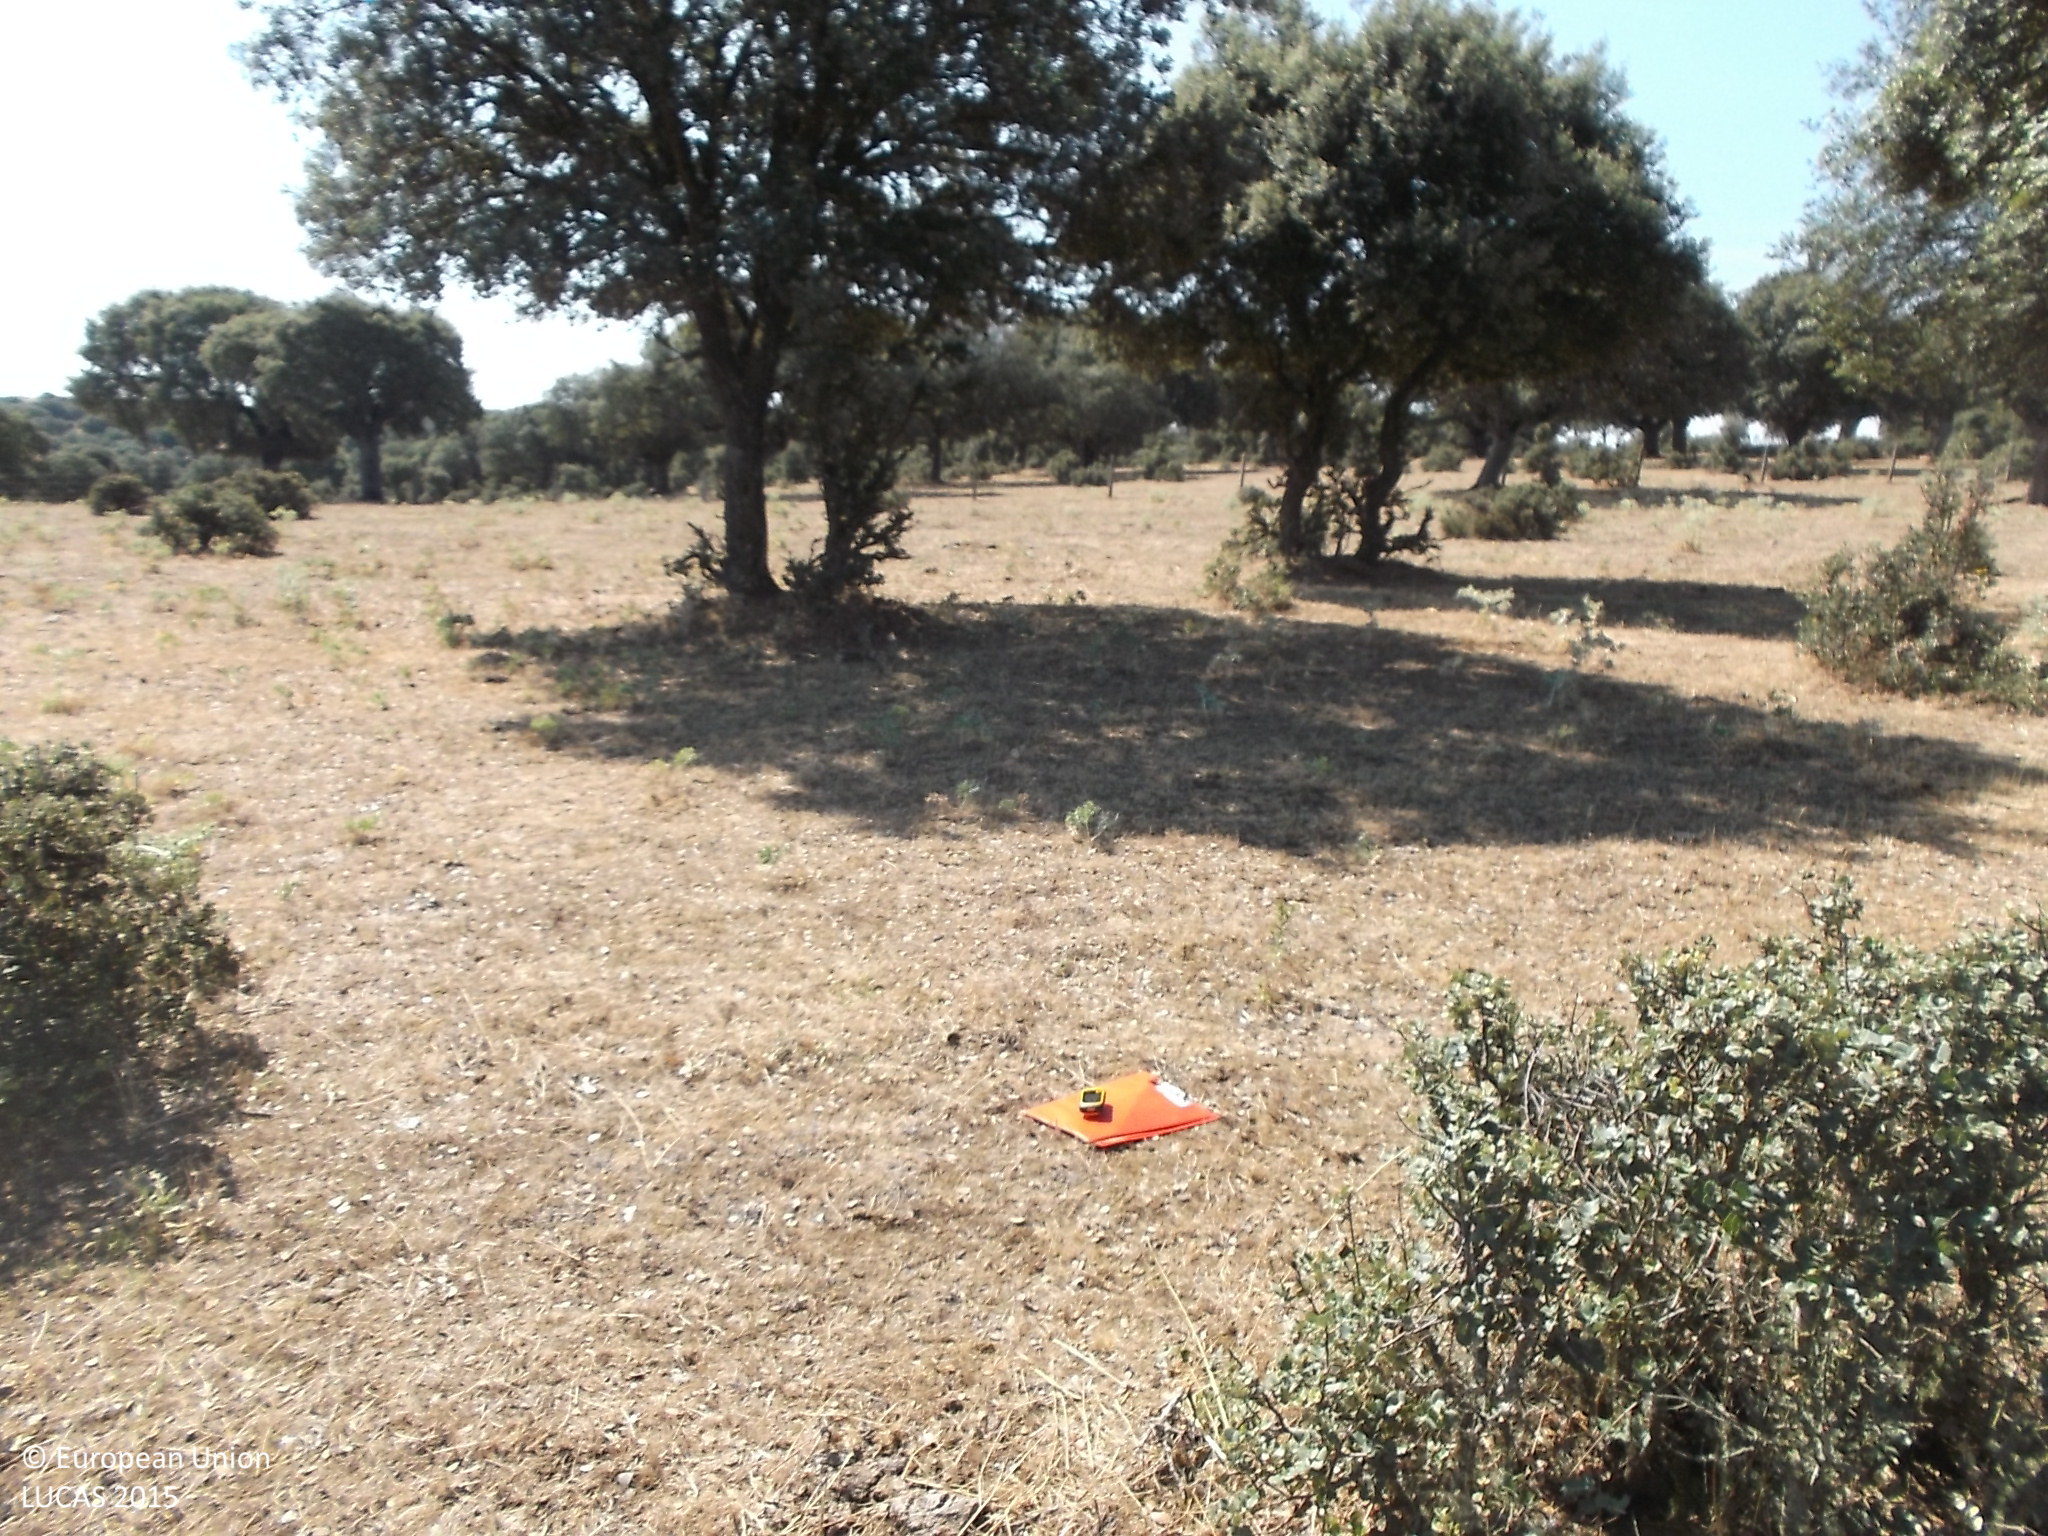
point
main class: Woodland
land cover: Broadleaved woodland
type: broadleaved evergreen forest
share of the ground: 25 - 50 %
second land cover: Shrubland without tree cover
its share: 50 - 75 %
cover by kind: herbaceous plants 40 %, broadleaved forest trees 30 %, shrubs 30 %
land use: Forestry
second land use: Agriculture (excluding fallow land and kitchen gardens)
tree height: < 5 m
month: July
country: ES
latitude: 41.1957
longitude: -5.9571
